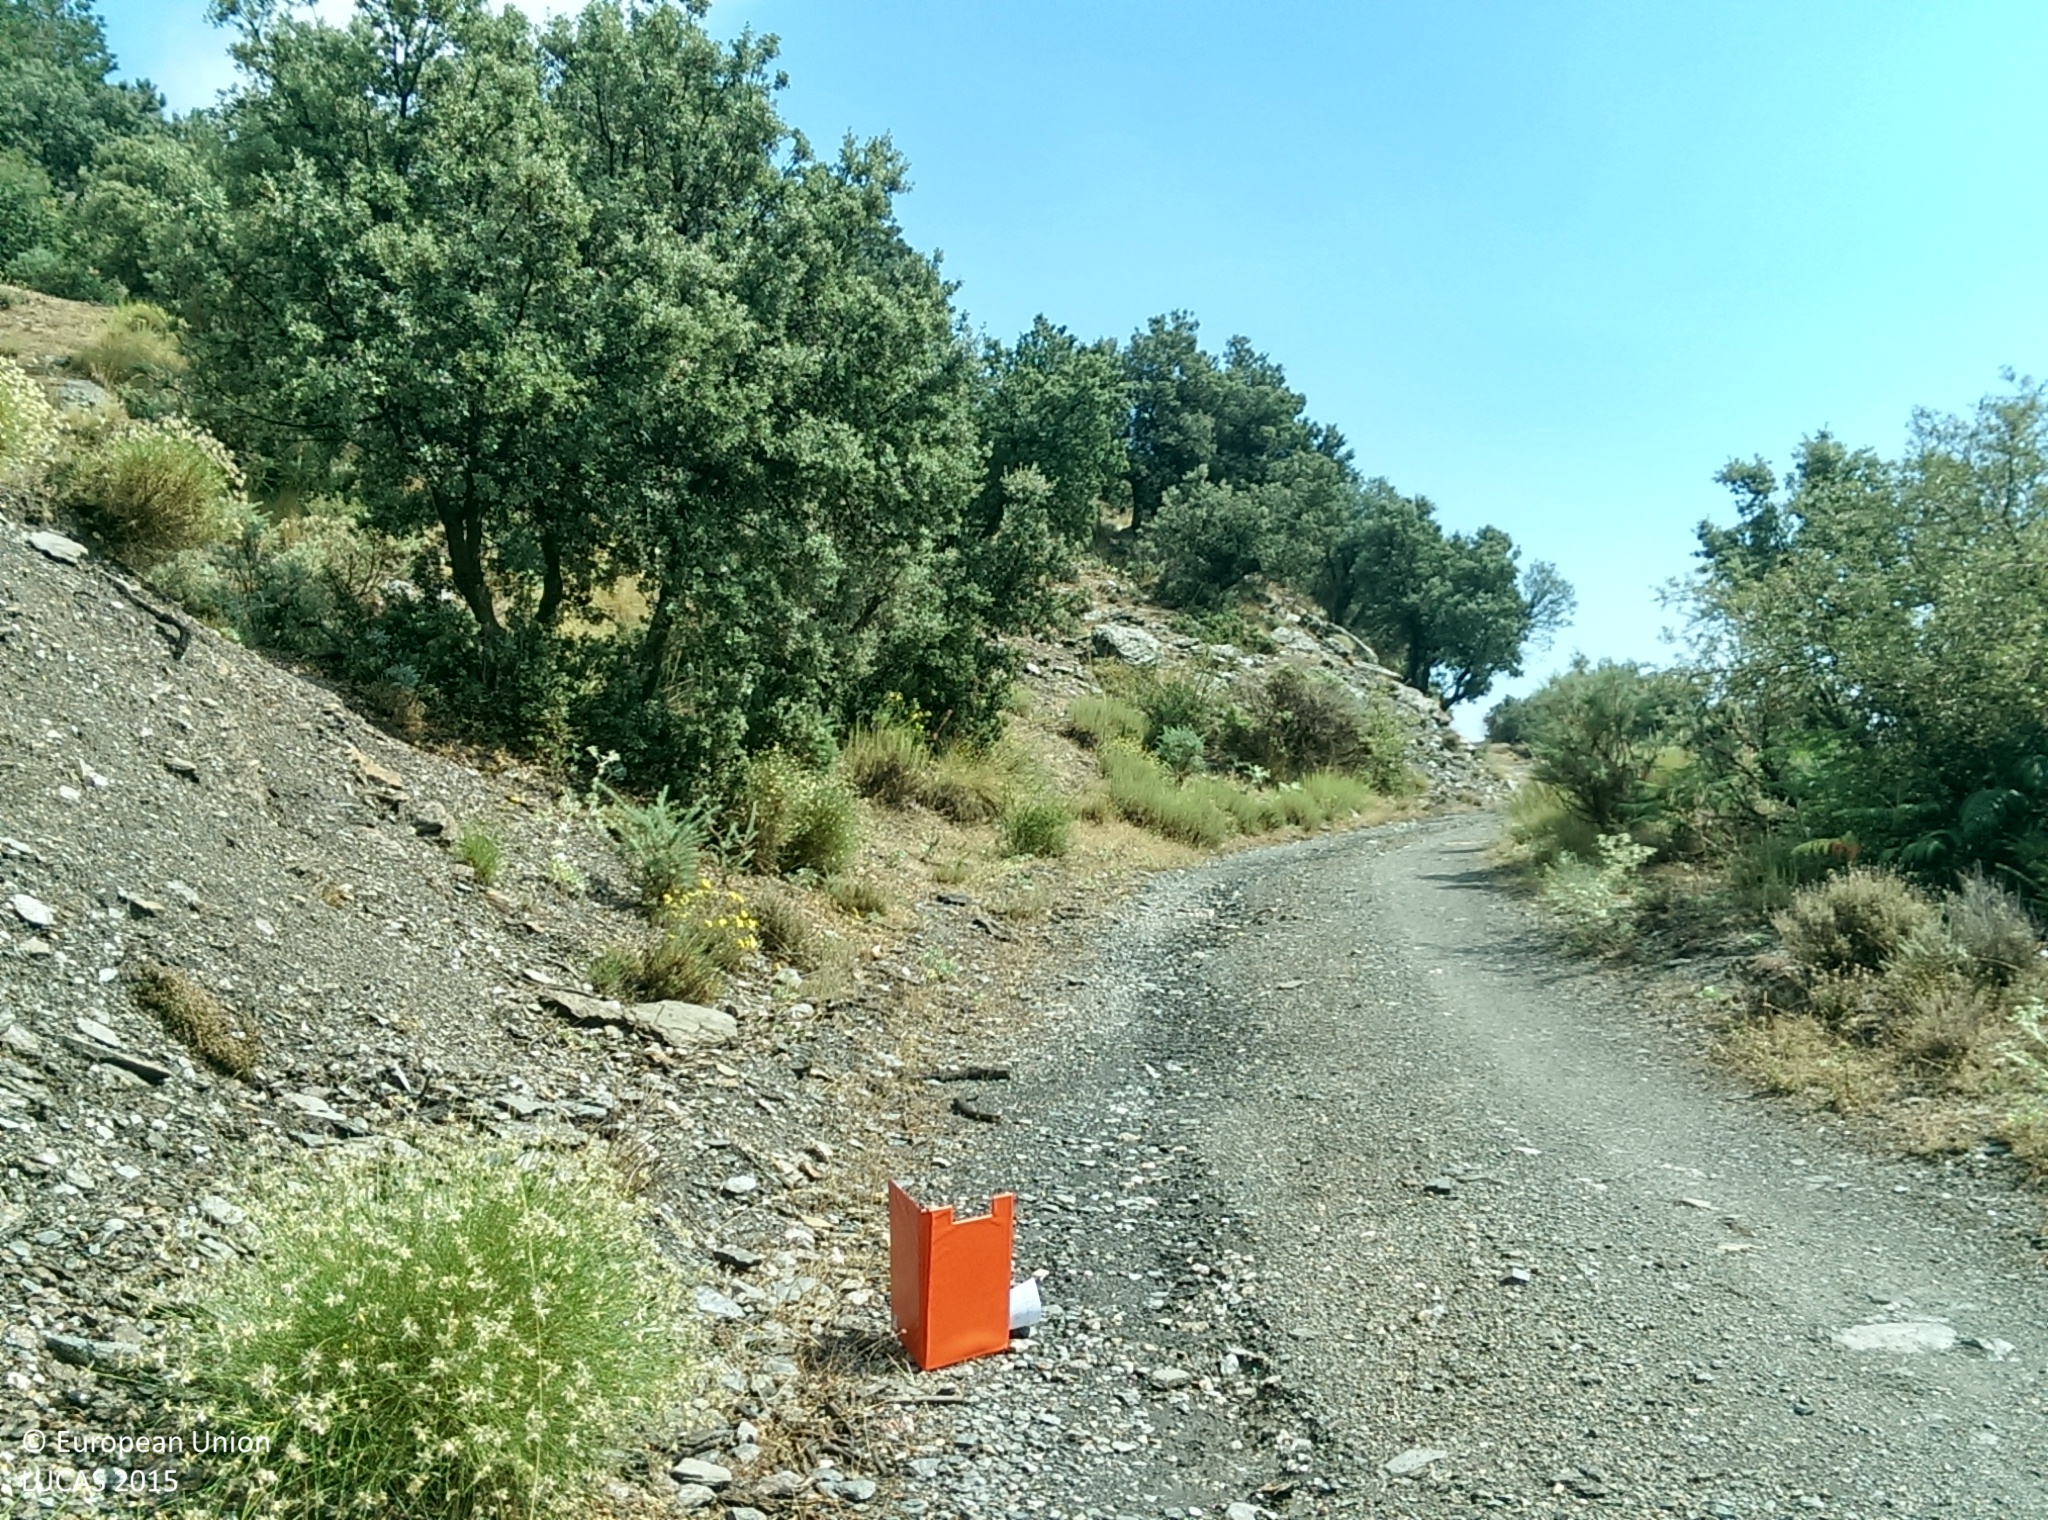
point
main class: Woodland
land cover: Broadleaved woodland
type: broadleaved evergreen forest
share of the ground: 50 - 75 %
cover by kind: broadleaved forest trees 65 %, shrubs 15 %, herbaceous plants 15 %, unconsolidated bare surface 5 %
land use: Forestry
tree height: > 5 m
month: July
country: ES
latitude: 37.0145
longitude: -3.1437
